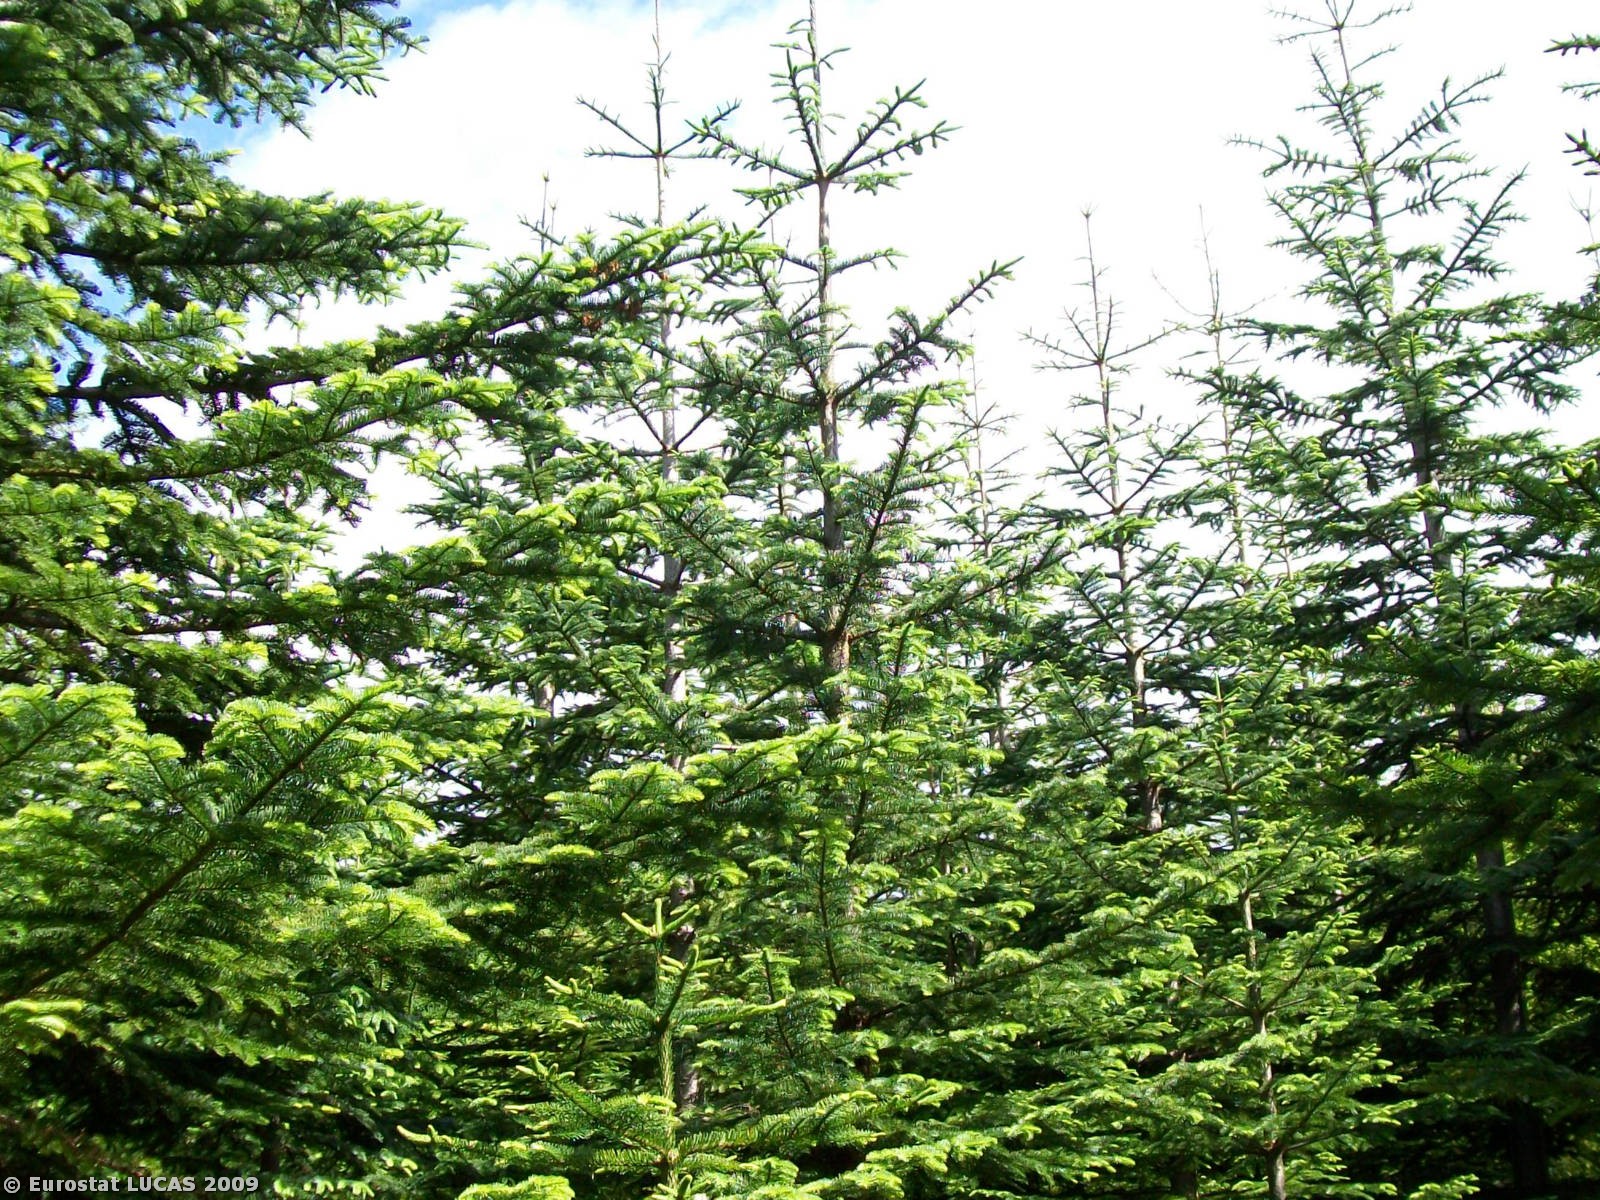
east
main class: Woodland
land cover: Coniferous woodland
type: plantations and self-sown exotic forest
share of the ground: 50 - 75 %
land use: Forestry
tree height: > 5 m
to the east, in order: Coniferous woodland; Grassland with sparse tree/shrub cover; Rivers and streams; Grassland with sparse tree/shrub cover; Tracks; Ditches and canals; Grassland without tree/shrub cover; Coniferous woodland
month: June
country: GB
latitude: 56.5048
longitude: -5.3398
